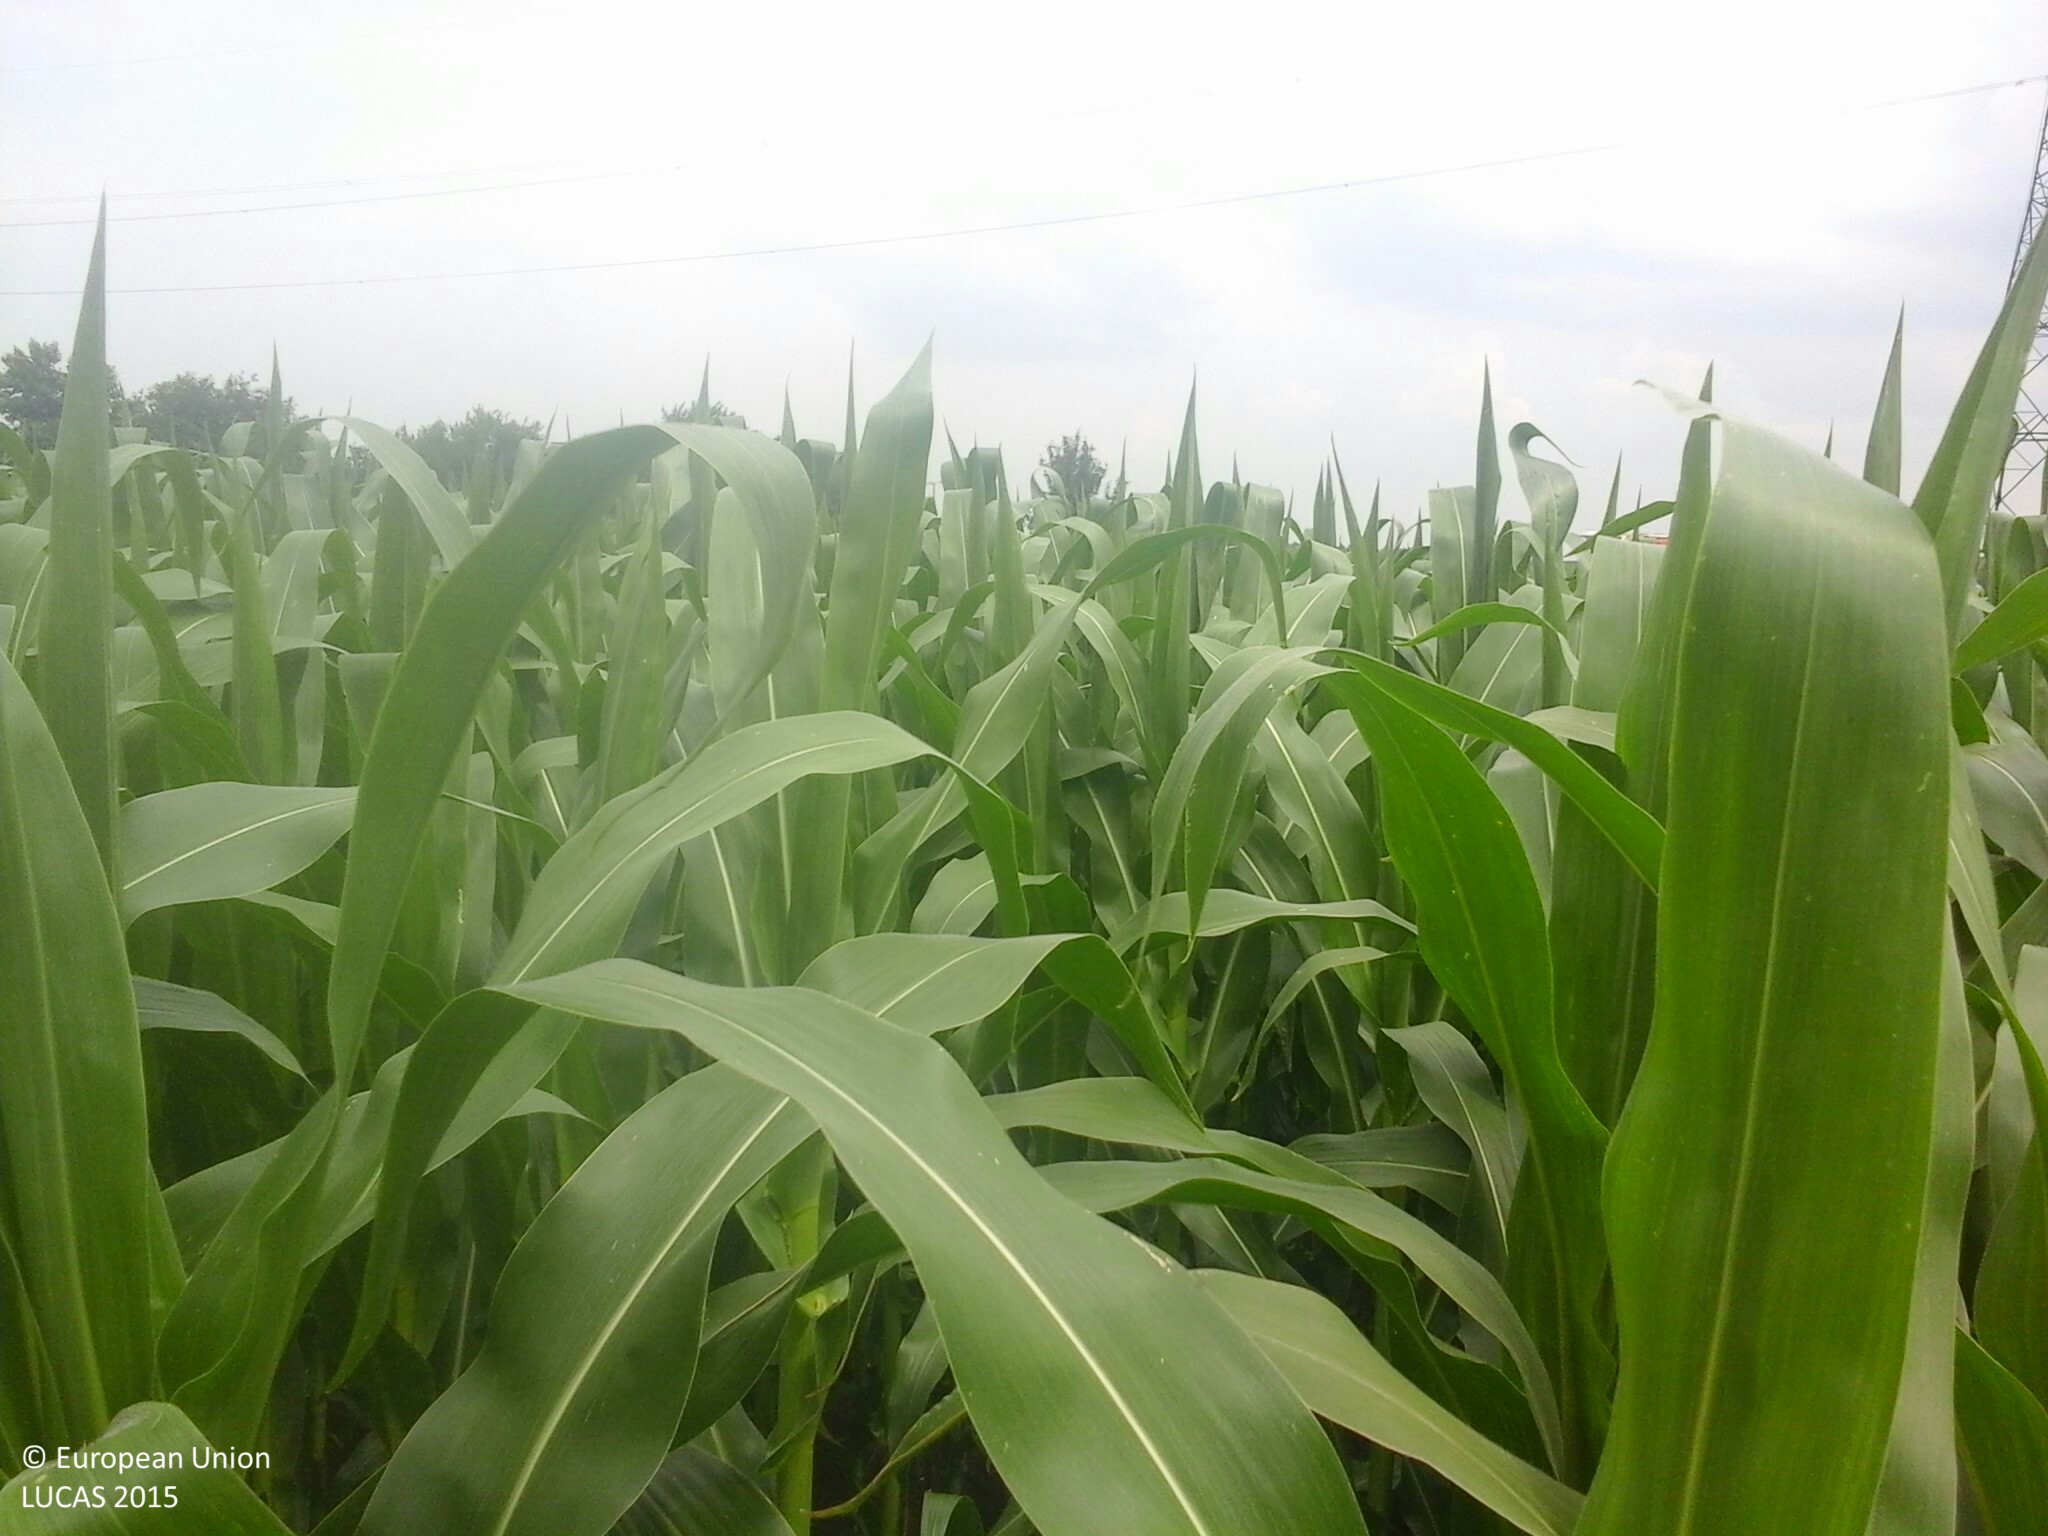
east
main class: Cropland
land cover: Maize
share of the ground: > 75 %
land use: Agriculture (excluding fallow land and kitchen gardens)
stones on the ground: < 10 %
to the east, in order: Maize; Artificial constructions in urban areas; Maize; Electric lines; Maize; Grass margins; Common wheat
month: June
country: HU
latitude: 47.3720
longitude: 19.3562
